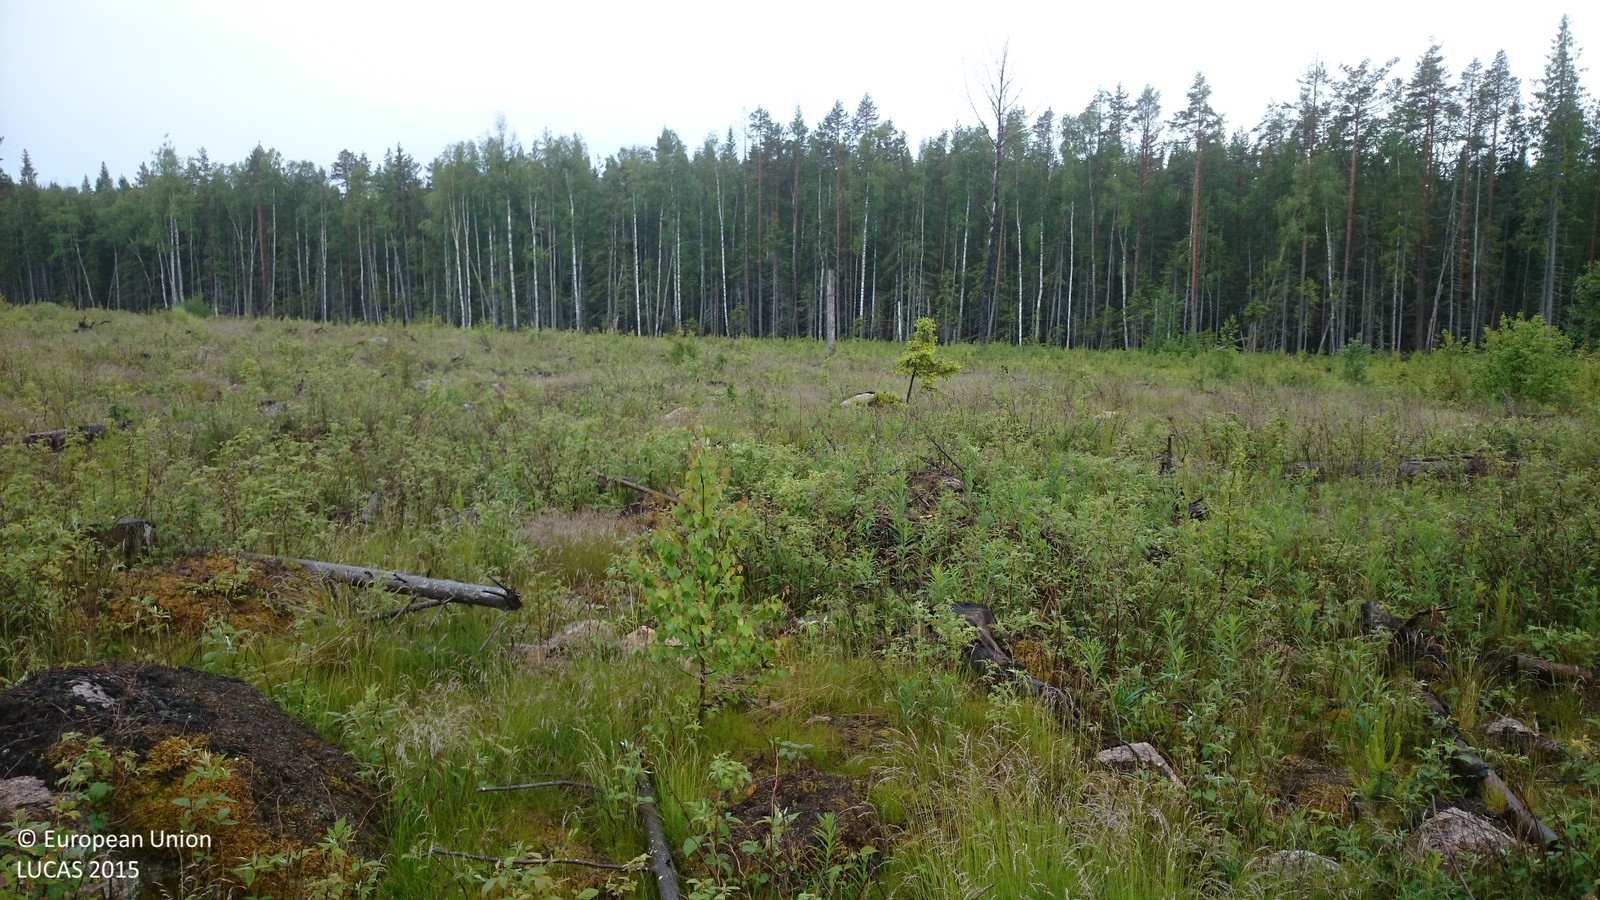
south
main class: Shrubland
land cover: Shrubland with sparse tree cover
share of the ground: 25 - 50 %
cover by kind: herbaceous plants 40 %, shrubs 30 %, lichens and mosses 25 %, coniferous forest trees 5 %
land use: Forestry
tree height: < 5 m
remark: Clear cut
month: June
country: SE
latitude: 61.9848
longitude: 16.8715
